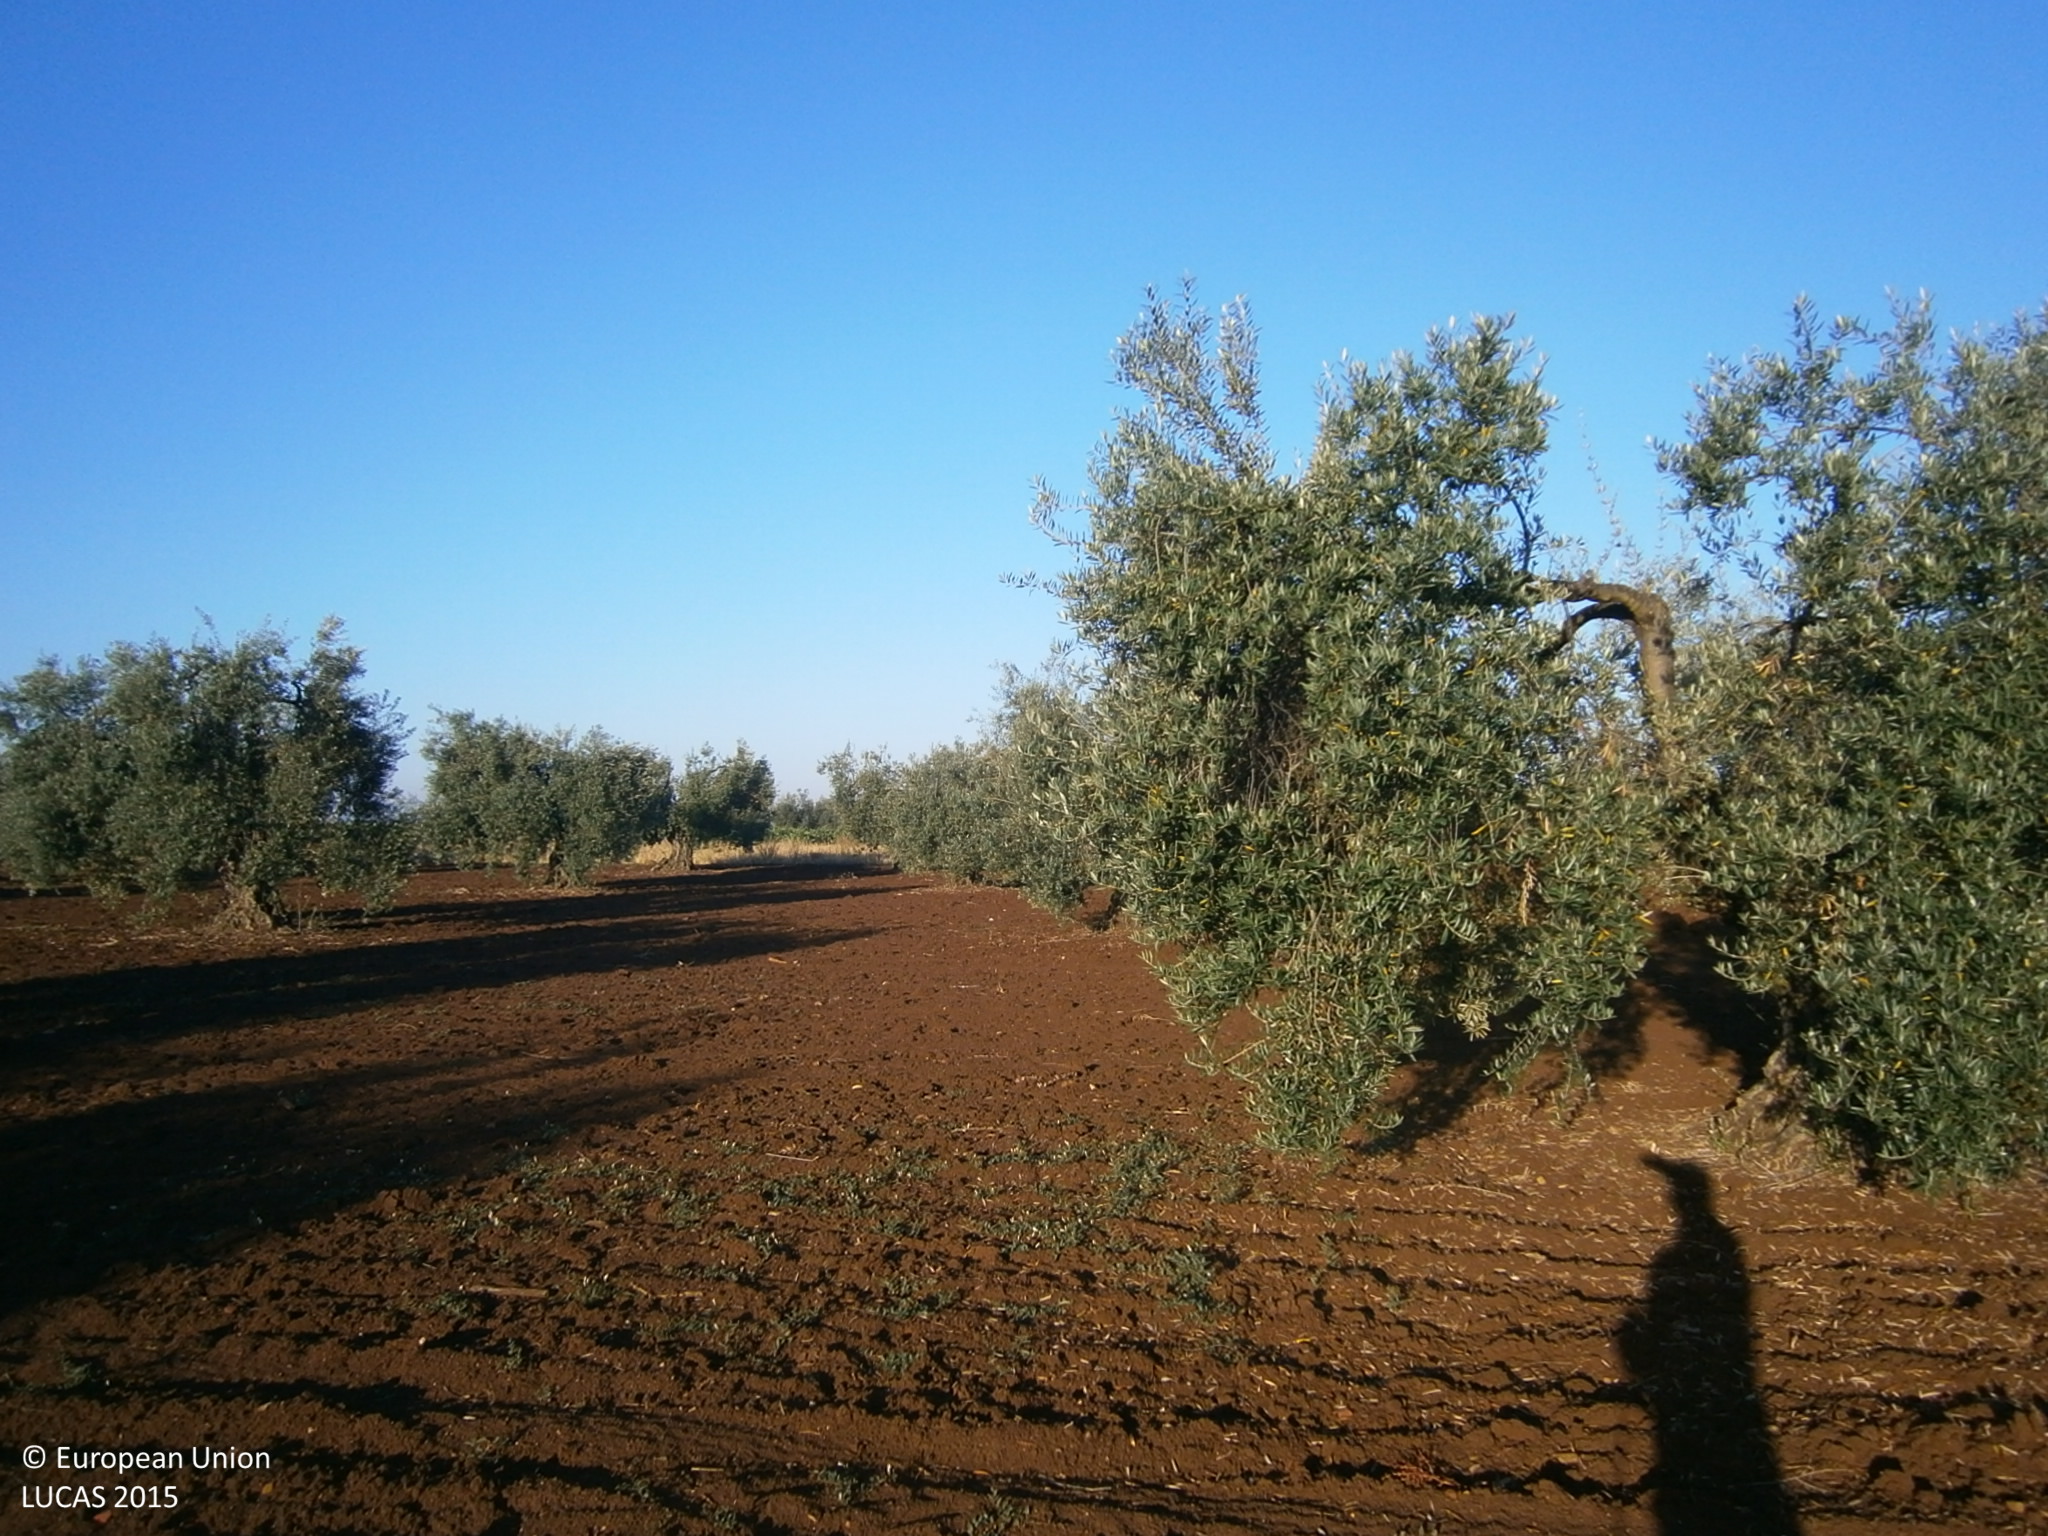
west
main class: Cropland
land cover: Olive groves
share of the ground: 10 - 25 %
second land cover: Other bare soil
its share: > 75 %
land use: Agriculture (excluding fallow land and kitchen gardens)
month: June
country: ES
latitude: 38.7467
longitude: -6.4056
